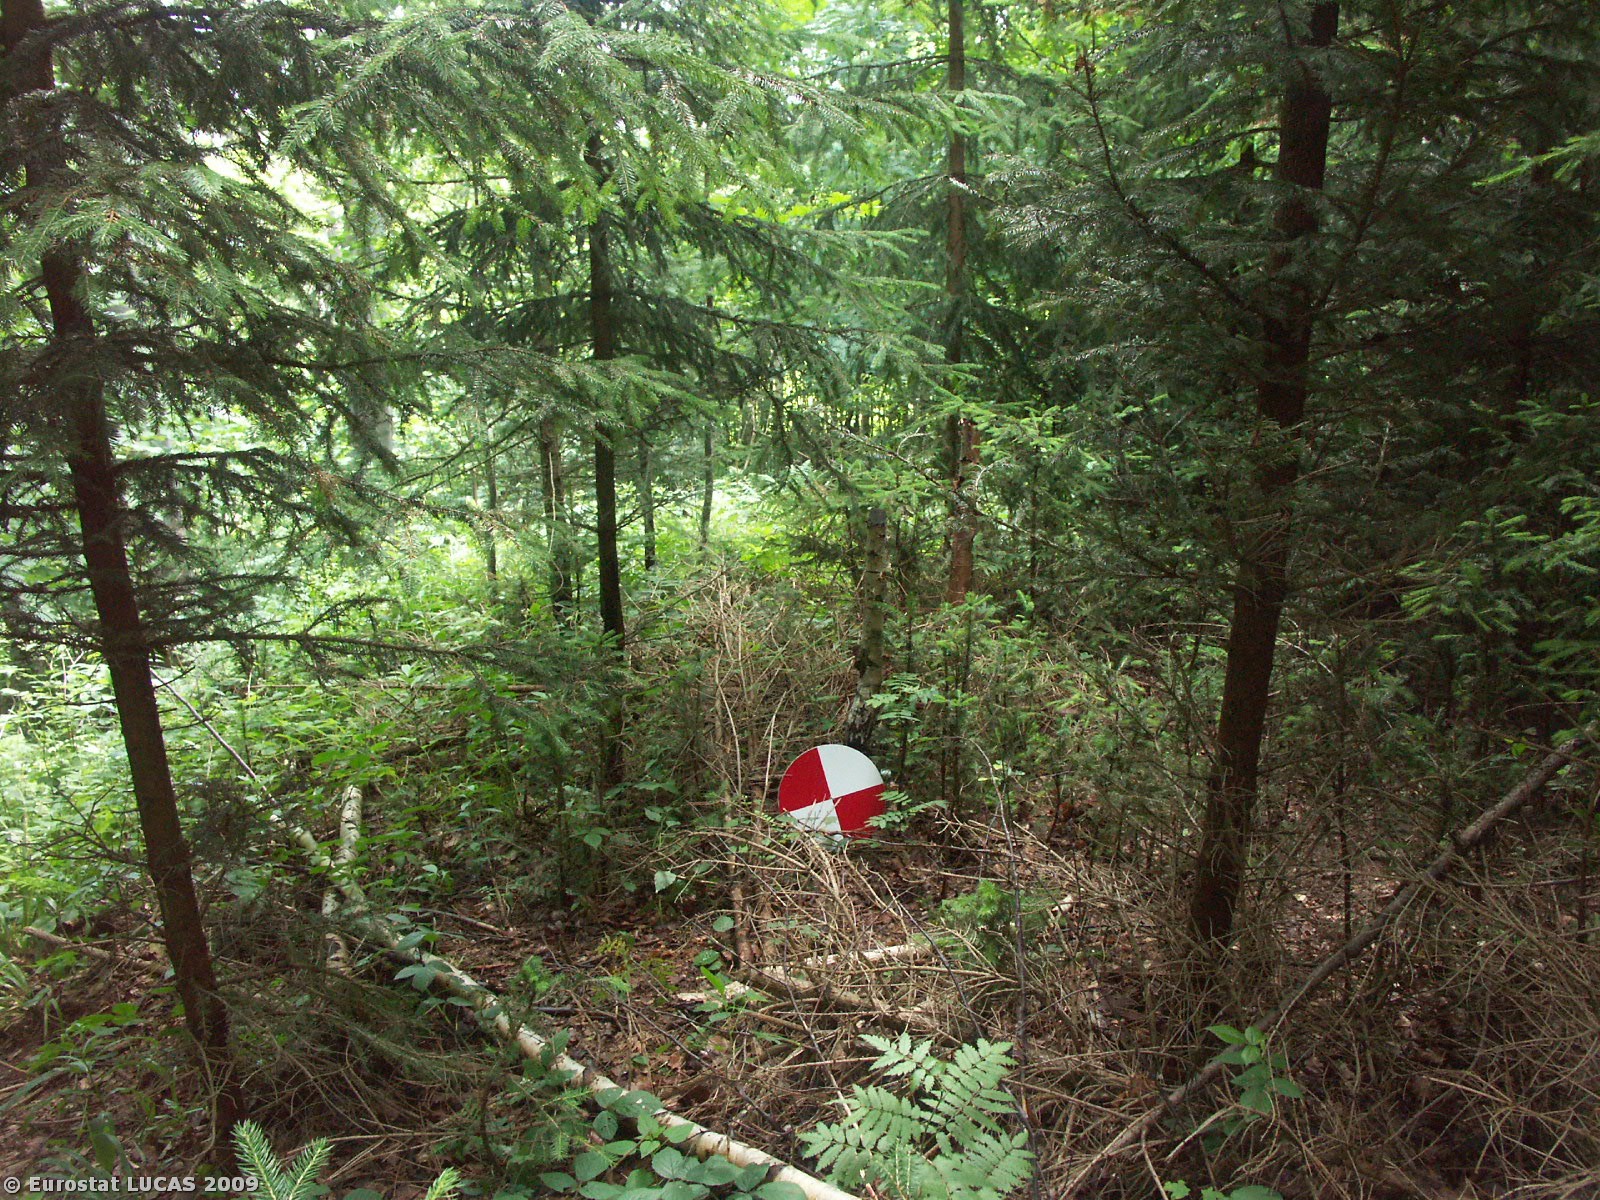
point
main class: Woodland
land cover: Mixed woodland
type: hemiboreal forest and nemoral coniferous forest and mixed broadleaved-coniferous forest
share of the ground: > 75 %
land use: Forestry
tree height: > 5 m
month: July
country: CZ
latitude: 49.8893
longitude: 17.4028
